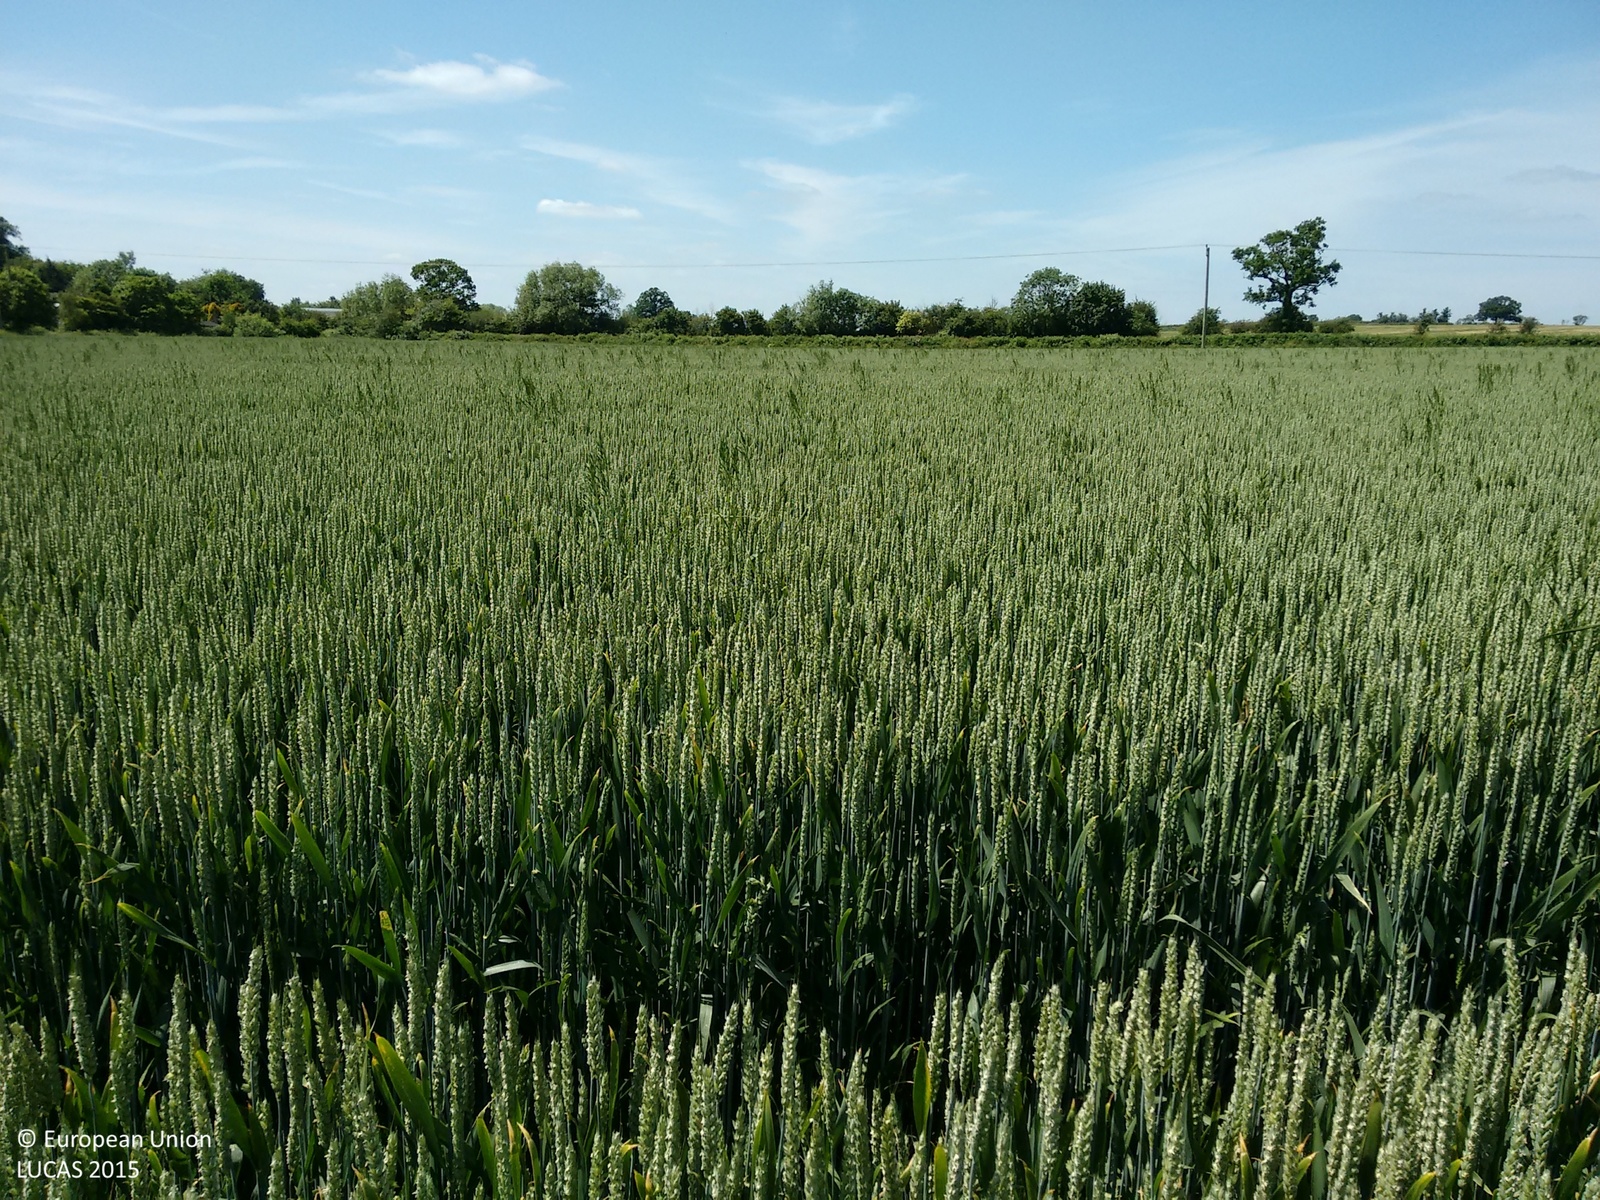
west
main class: Cropland
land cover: Common wheat
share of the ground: > 75 %
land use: Agriculture (excluding fallow land and kitchen gardens)
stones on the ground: < 10 %
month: June
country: GB
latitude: 51.8391
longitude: -1.2671
